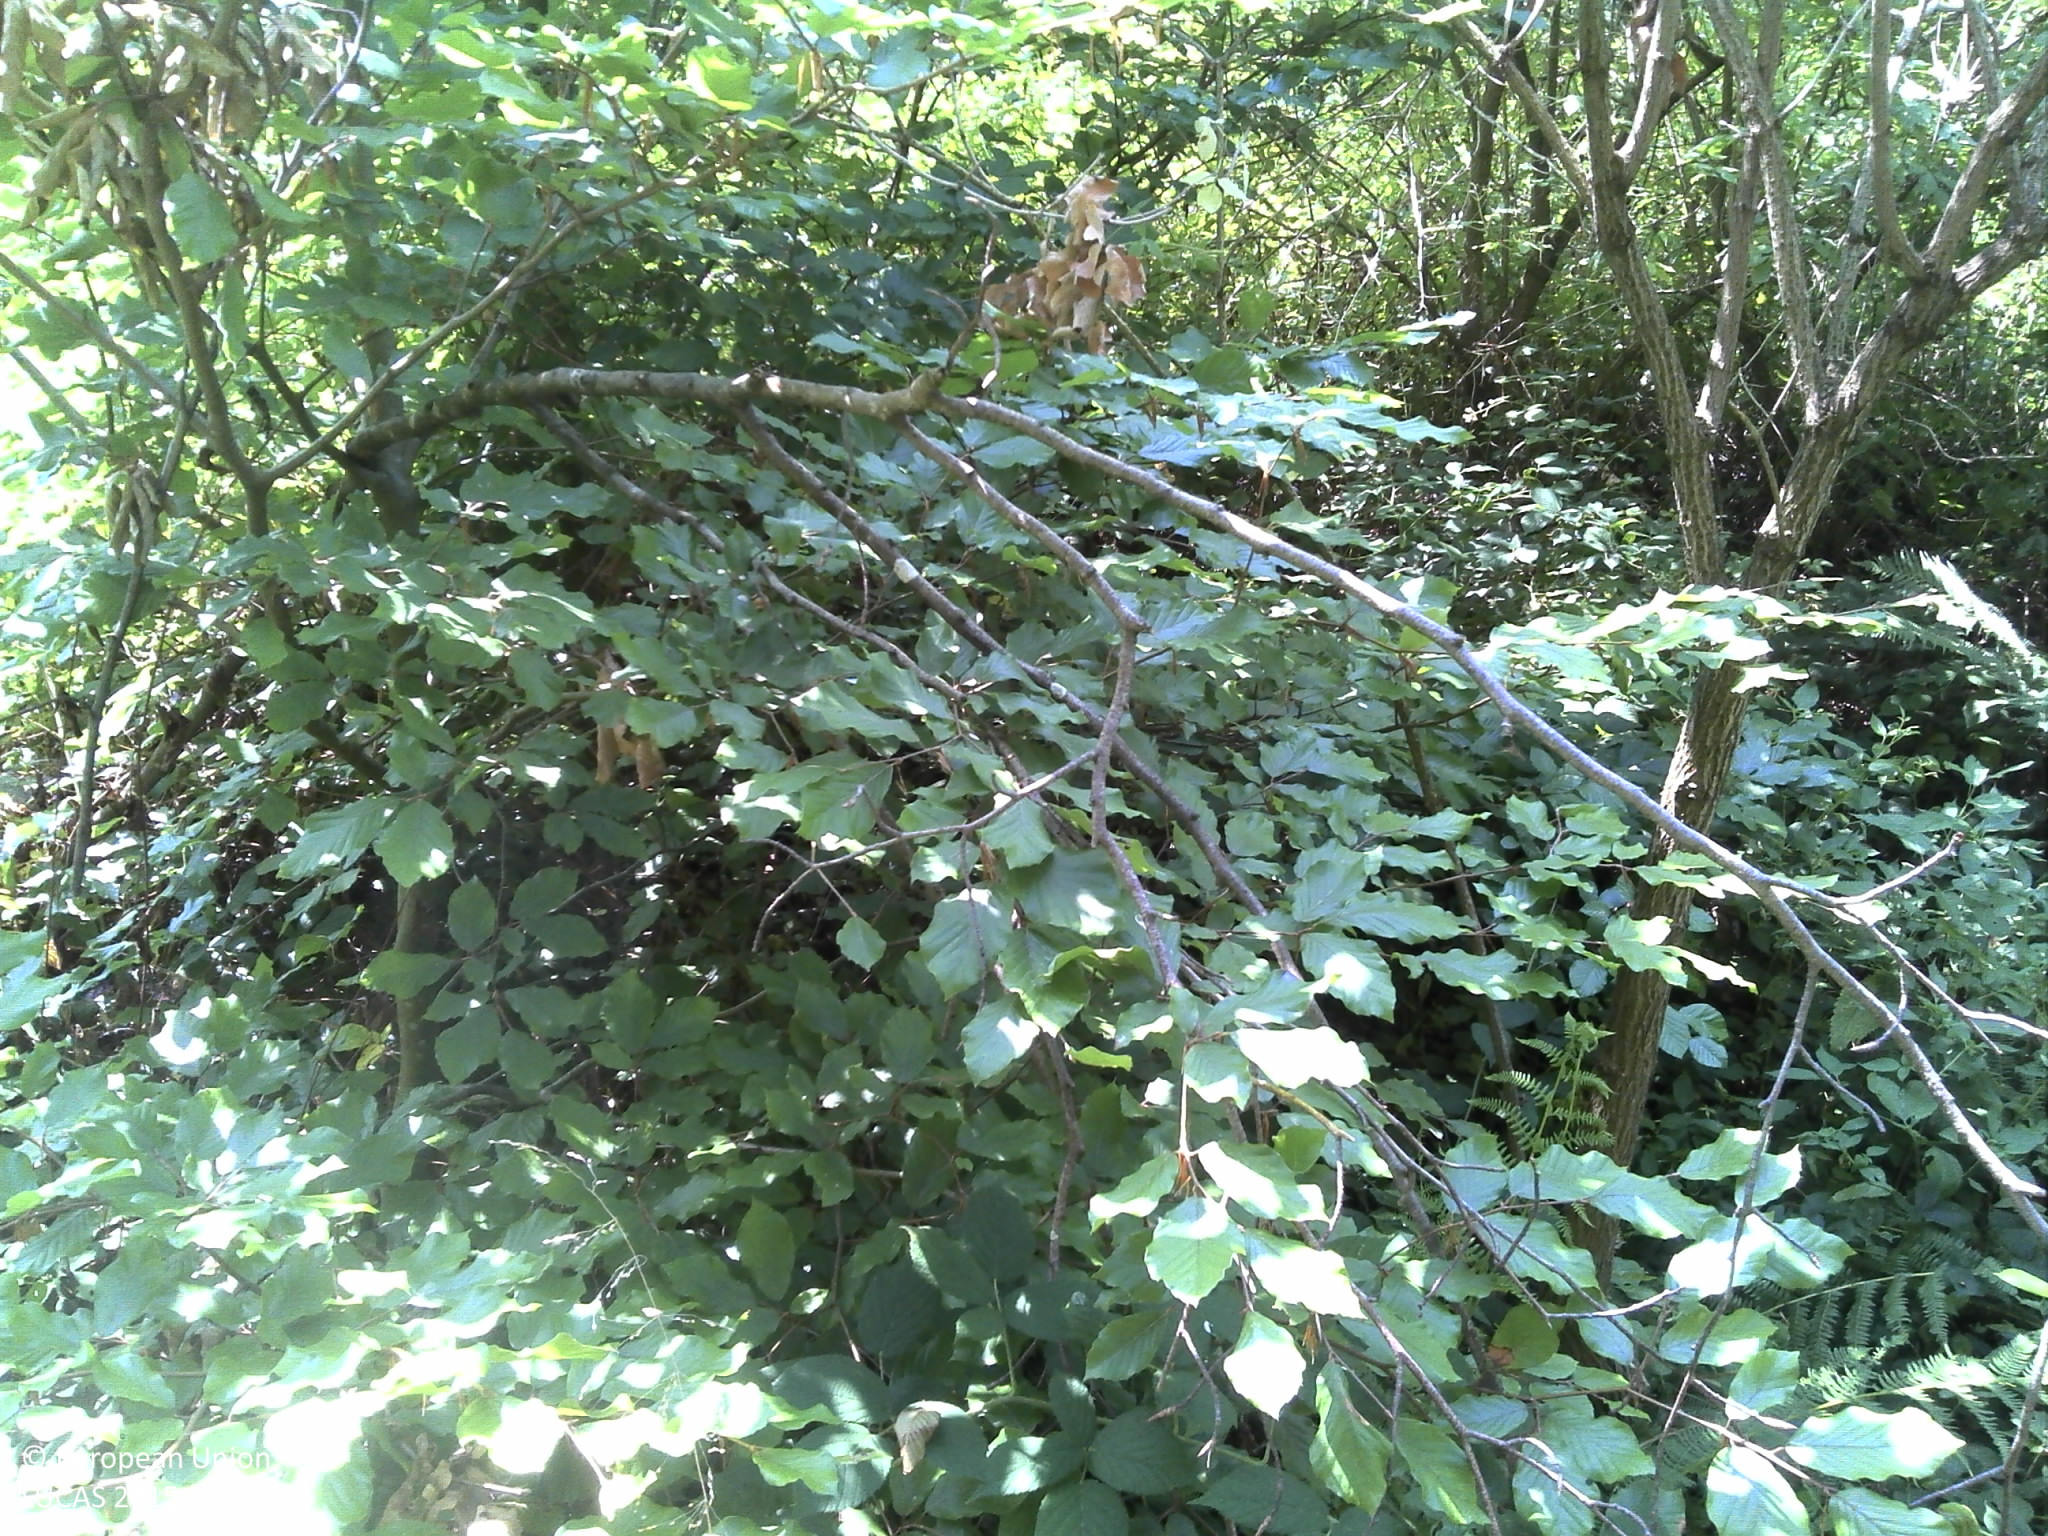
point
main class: Woodland
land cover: Broadleaved woodland
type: beech forest
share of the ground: > 75 %
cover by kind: broadleaved forest trees 100 %
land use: Forestry
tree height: > 5 m
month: July
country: HR
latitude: 45.6581
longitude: 17.1748
